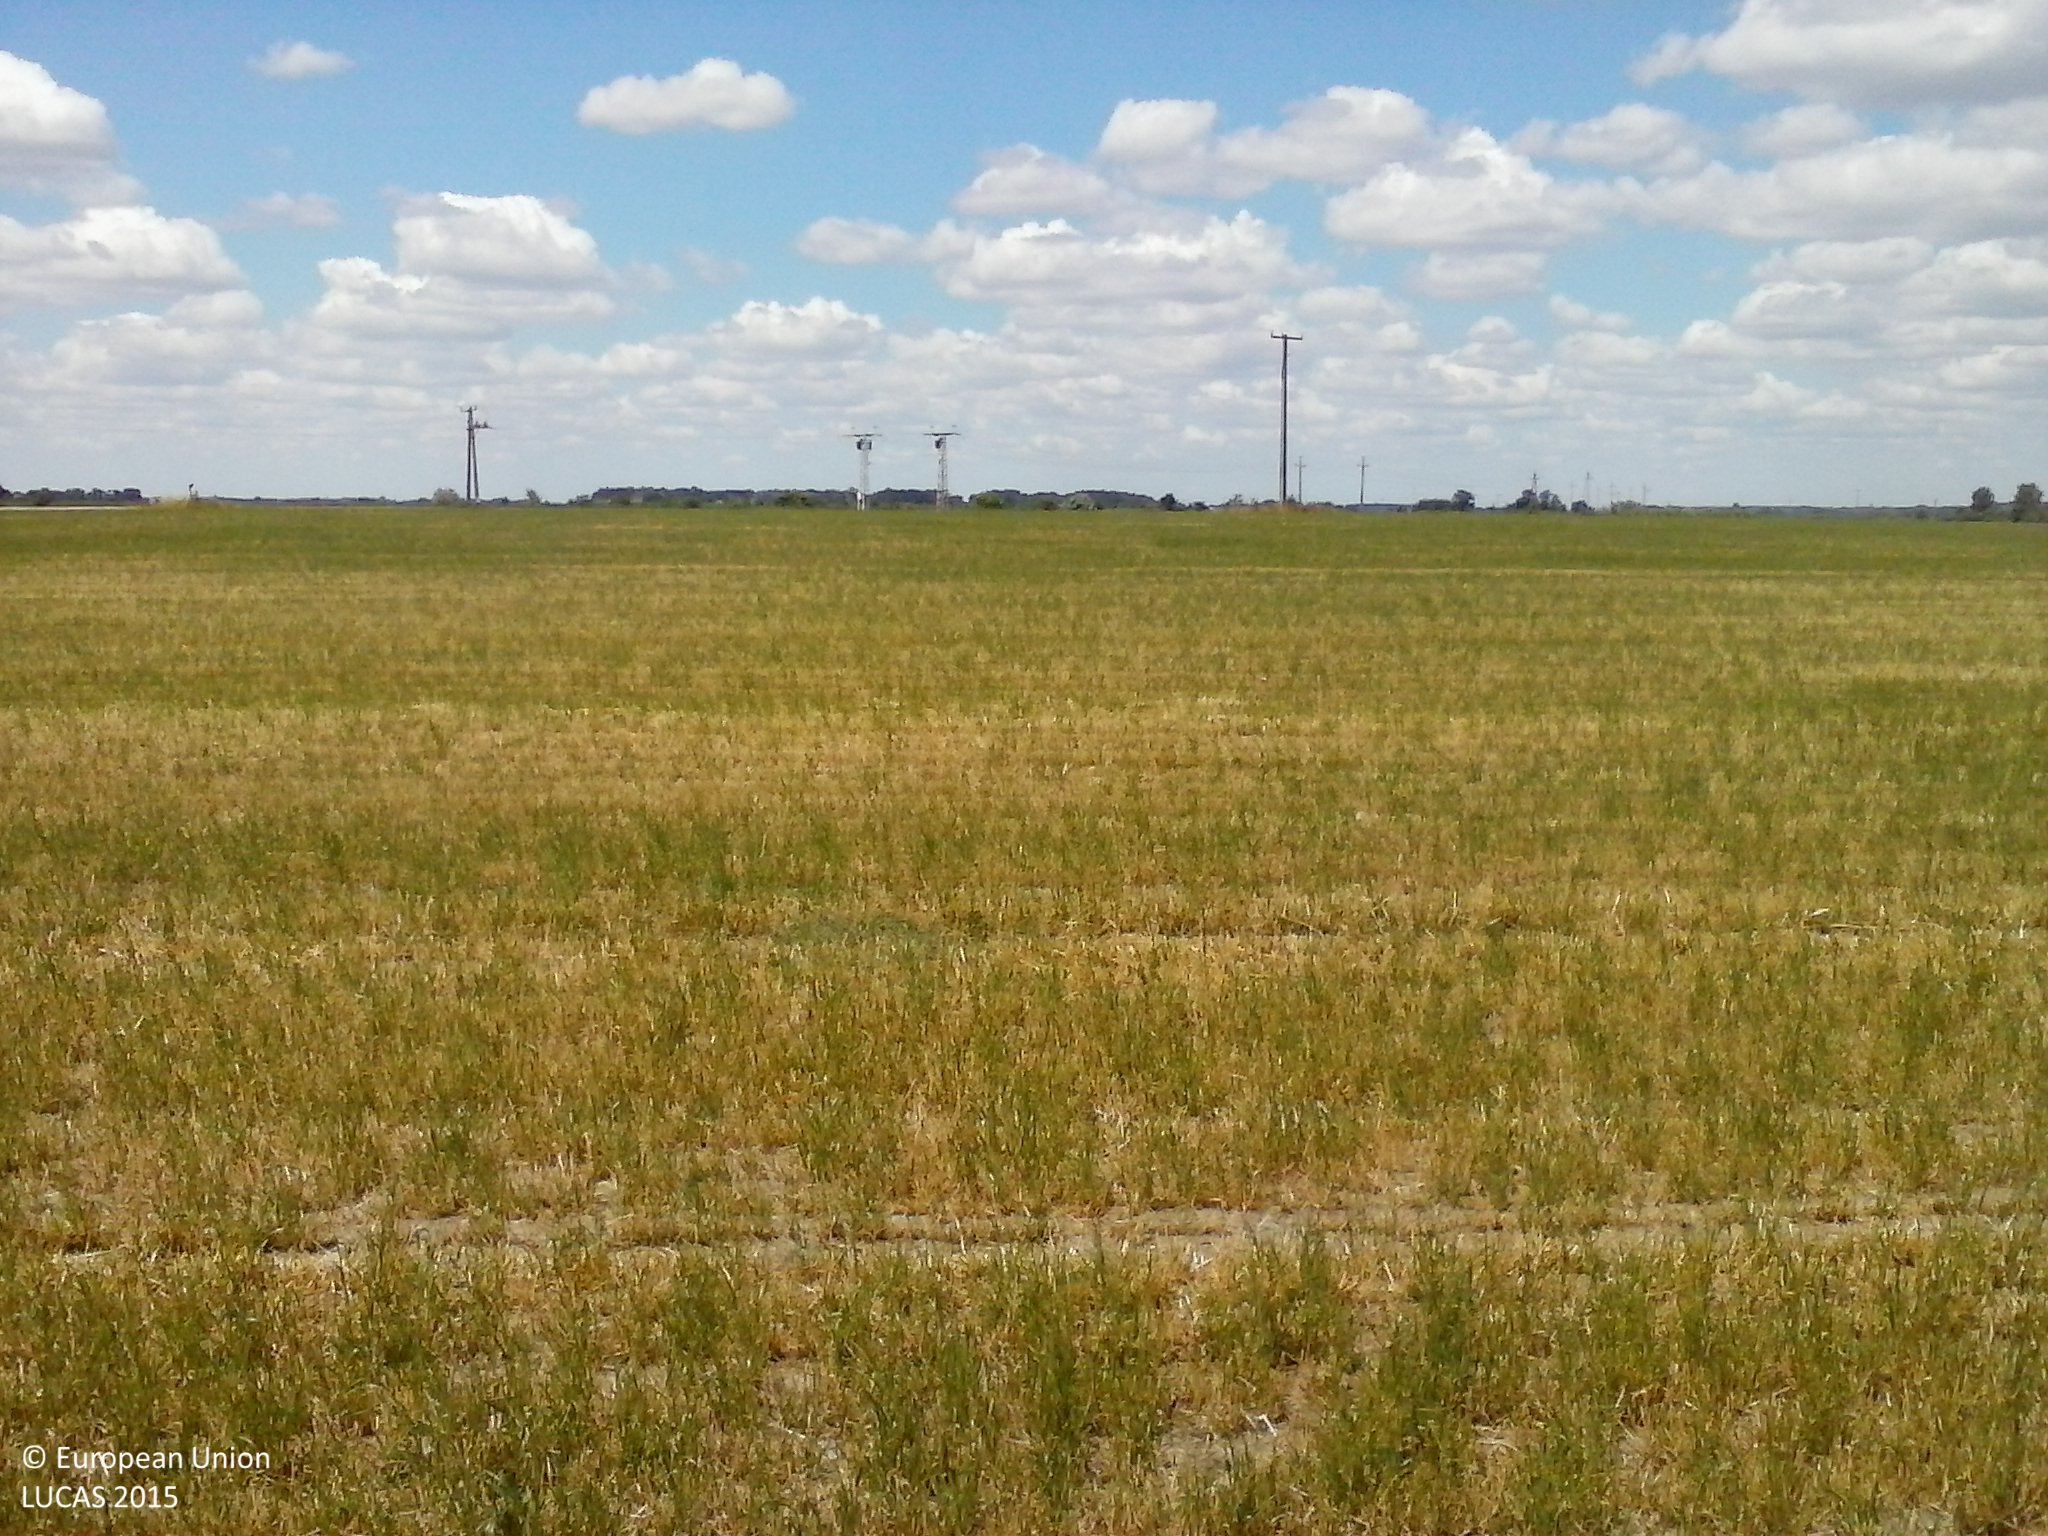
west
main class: Cropland
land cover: Common wheat
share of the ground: < 10 %
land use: Agriculture (excluding fallow land and kitchen gardens)
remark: Harvested field
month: June
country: HU
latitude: 46.2154
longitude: 20.3027
